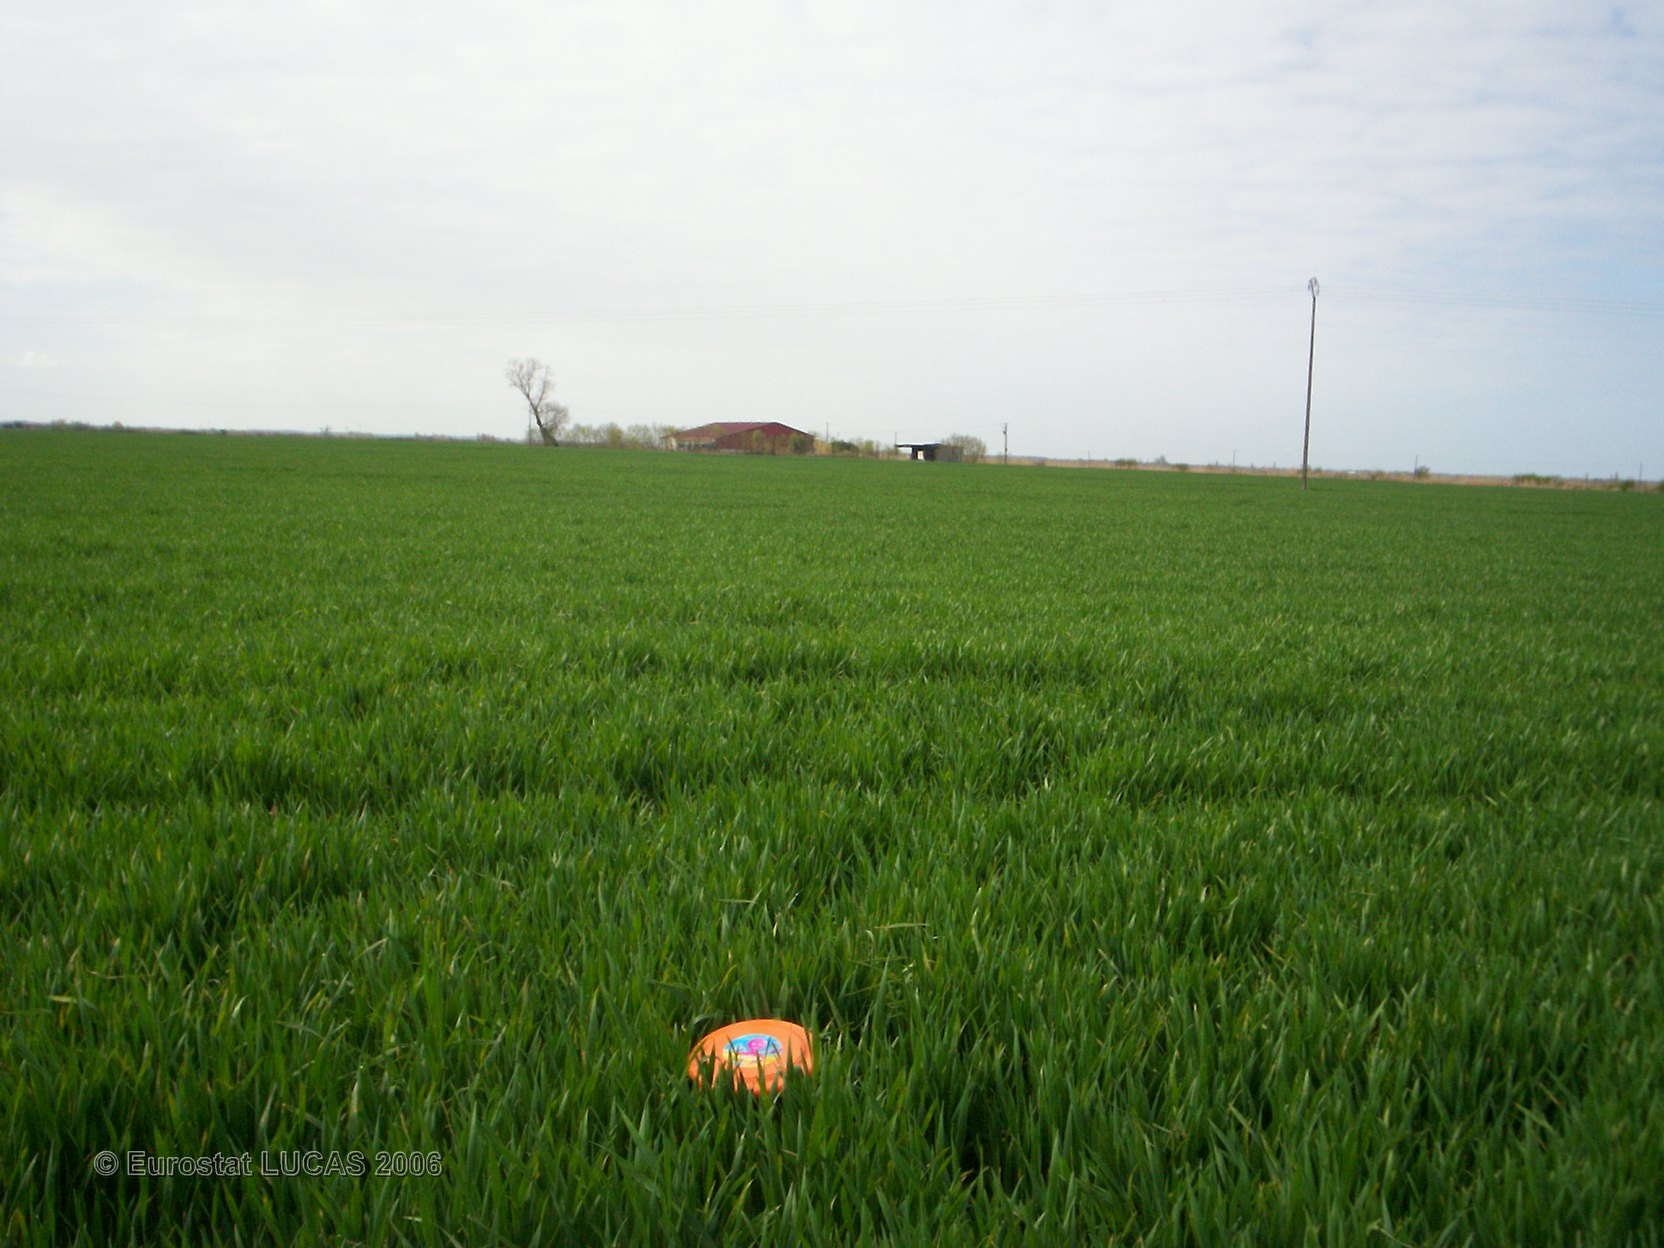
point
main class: Cropland
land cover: Rye
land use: Agriculture (excluding fallow land and kitchen gardens)
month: April
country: FR
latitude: 46.2784
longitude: -0.9444
